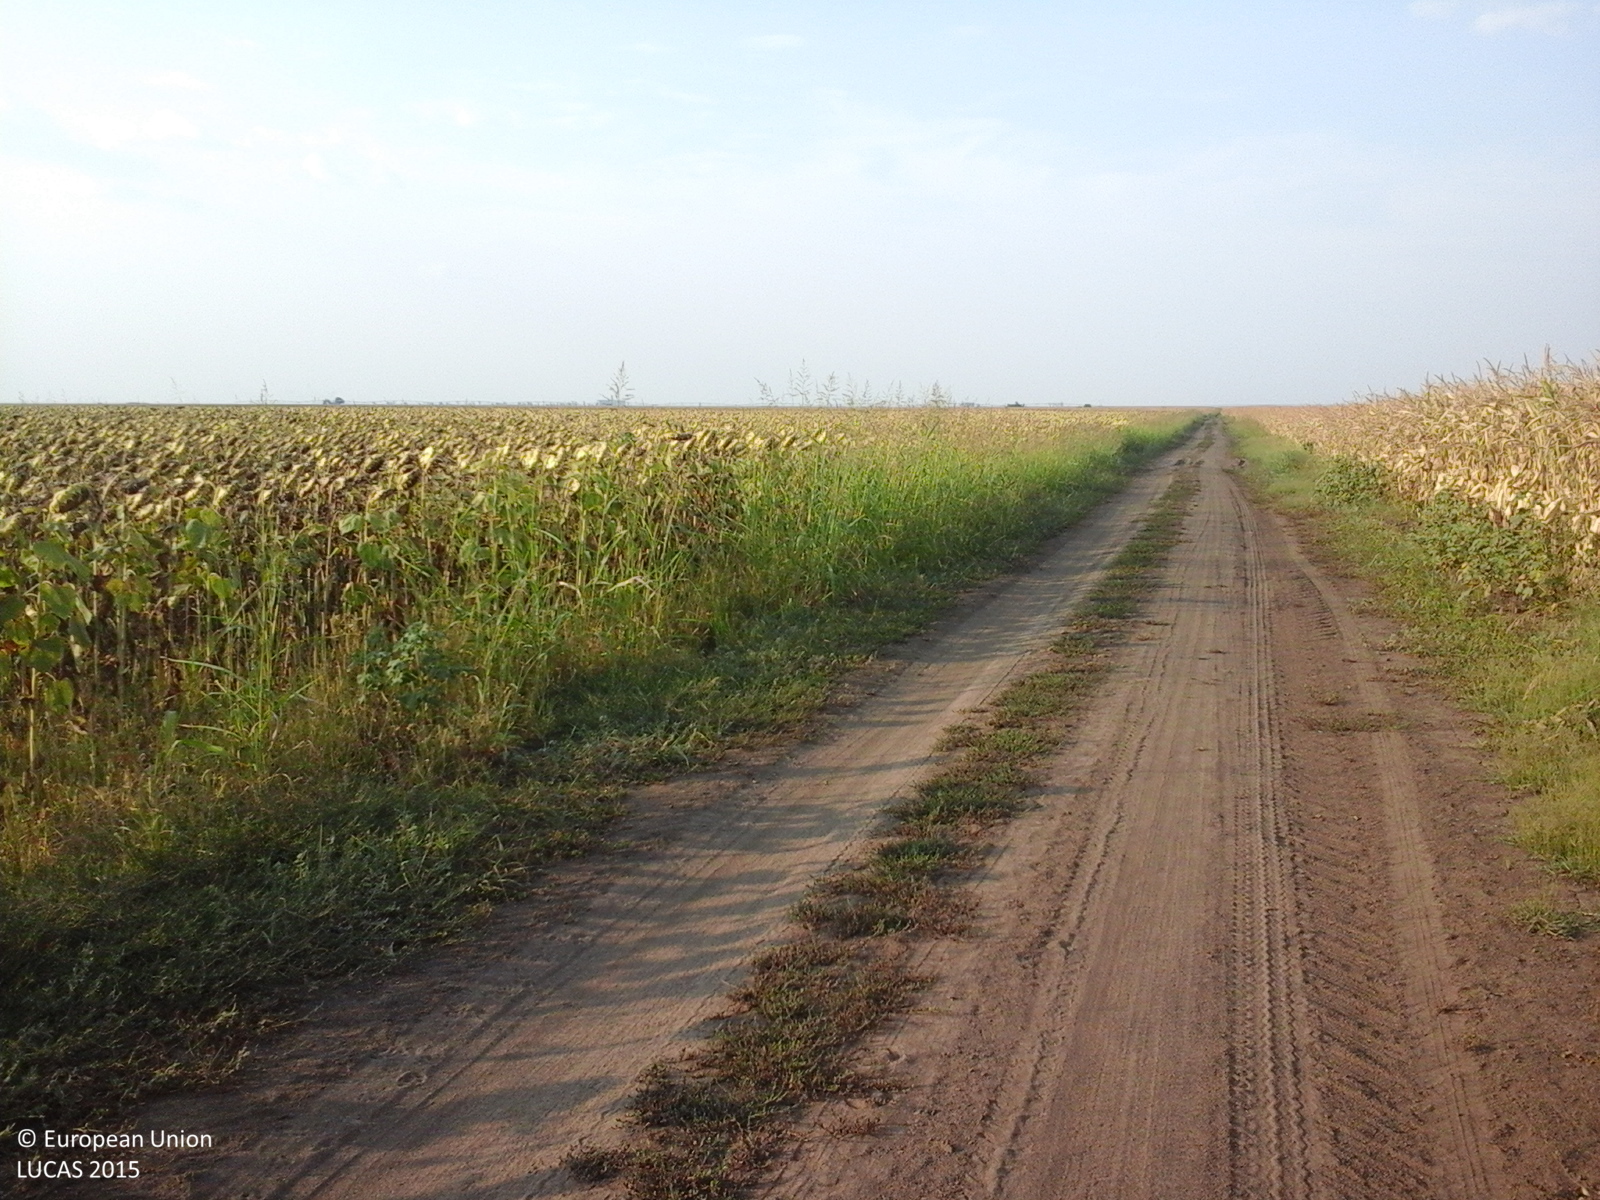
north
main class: Cropland
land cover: Maize
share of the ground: > 75 %
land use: Agriculture (excluding fallow land and kitchen gardens)
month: August
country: RO
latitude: 43.9783
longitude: 23.1962
